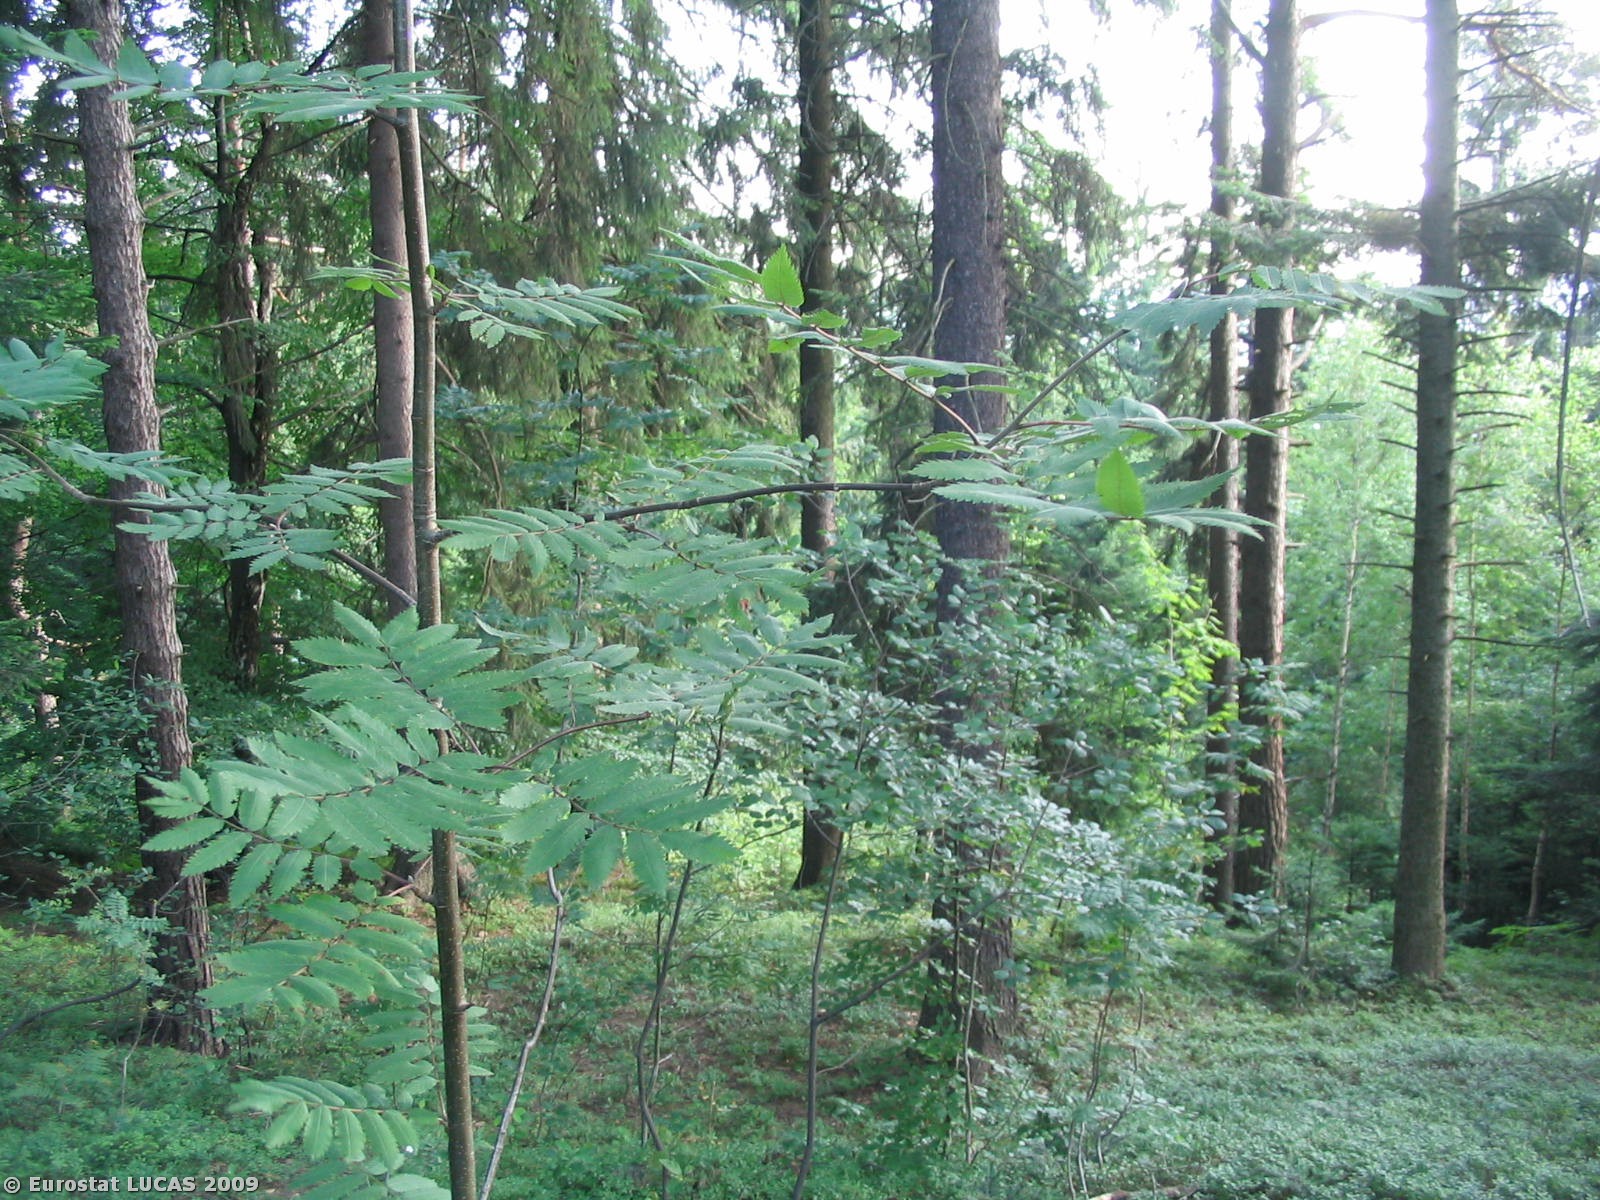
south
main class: Woodland
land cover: Mixed woodland
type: hemiboreal forest and nemoral coniferous forest and mixed broadleaved-coniferous forest
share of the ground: > 75 %
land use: Forestry
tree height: > 5 m
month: July
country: CZ
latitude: 49.6119
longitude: 18.7533
